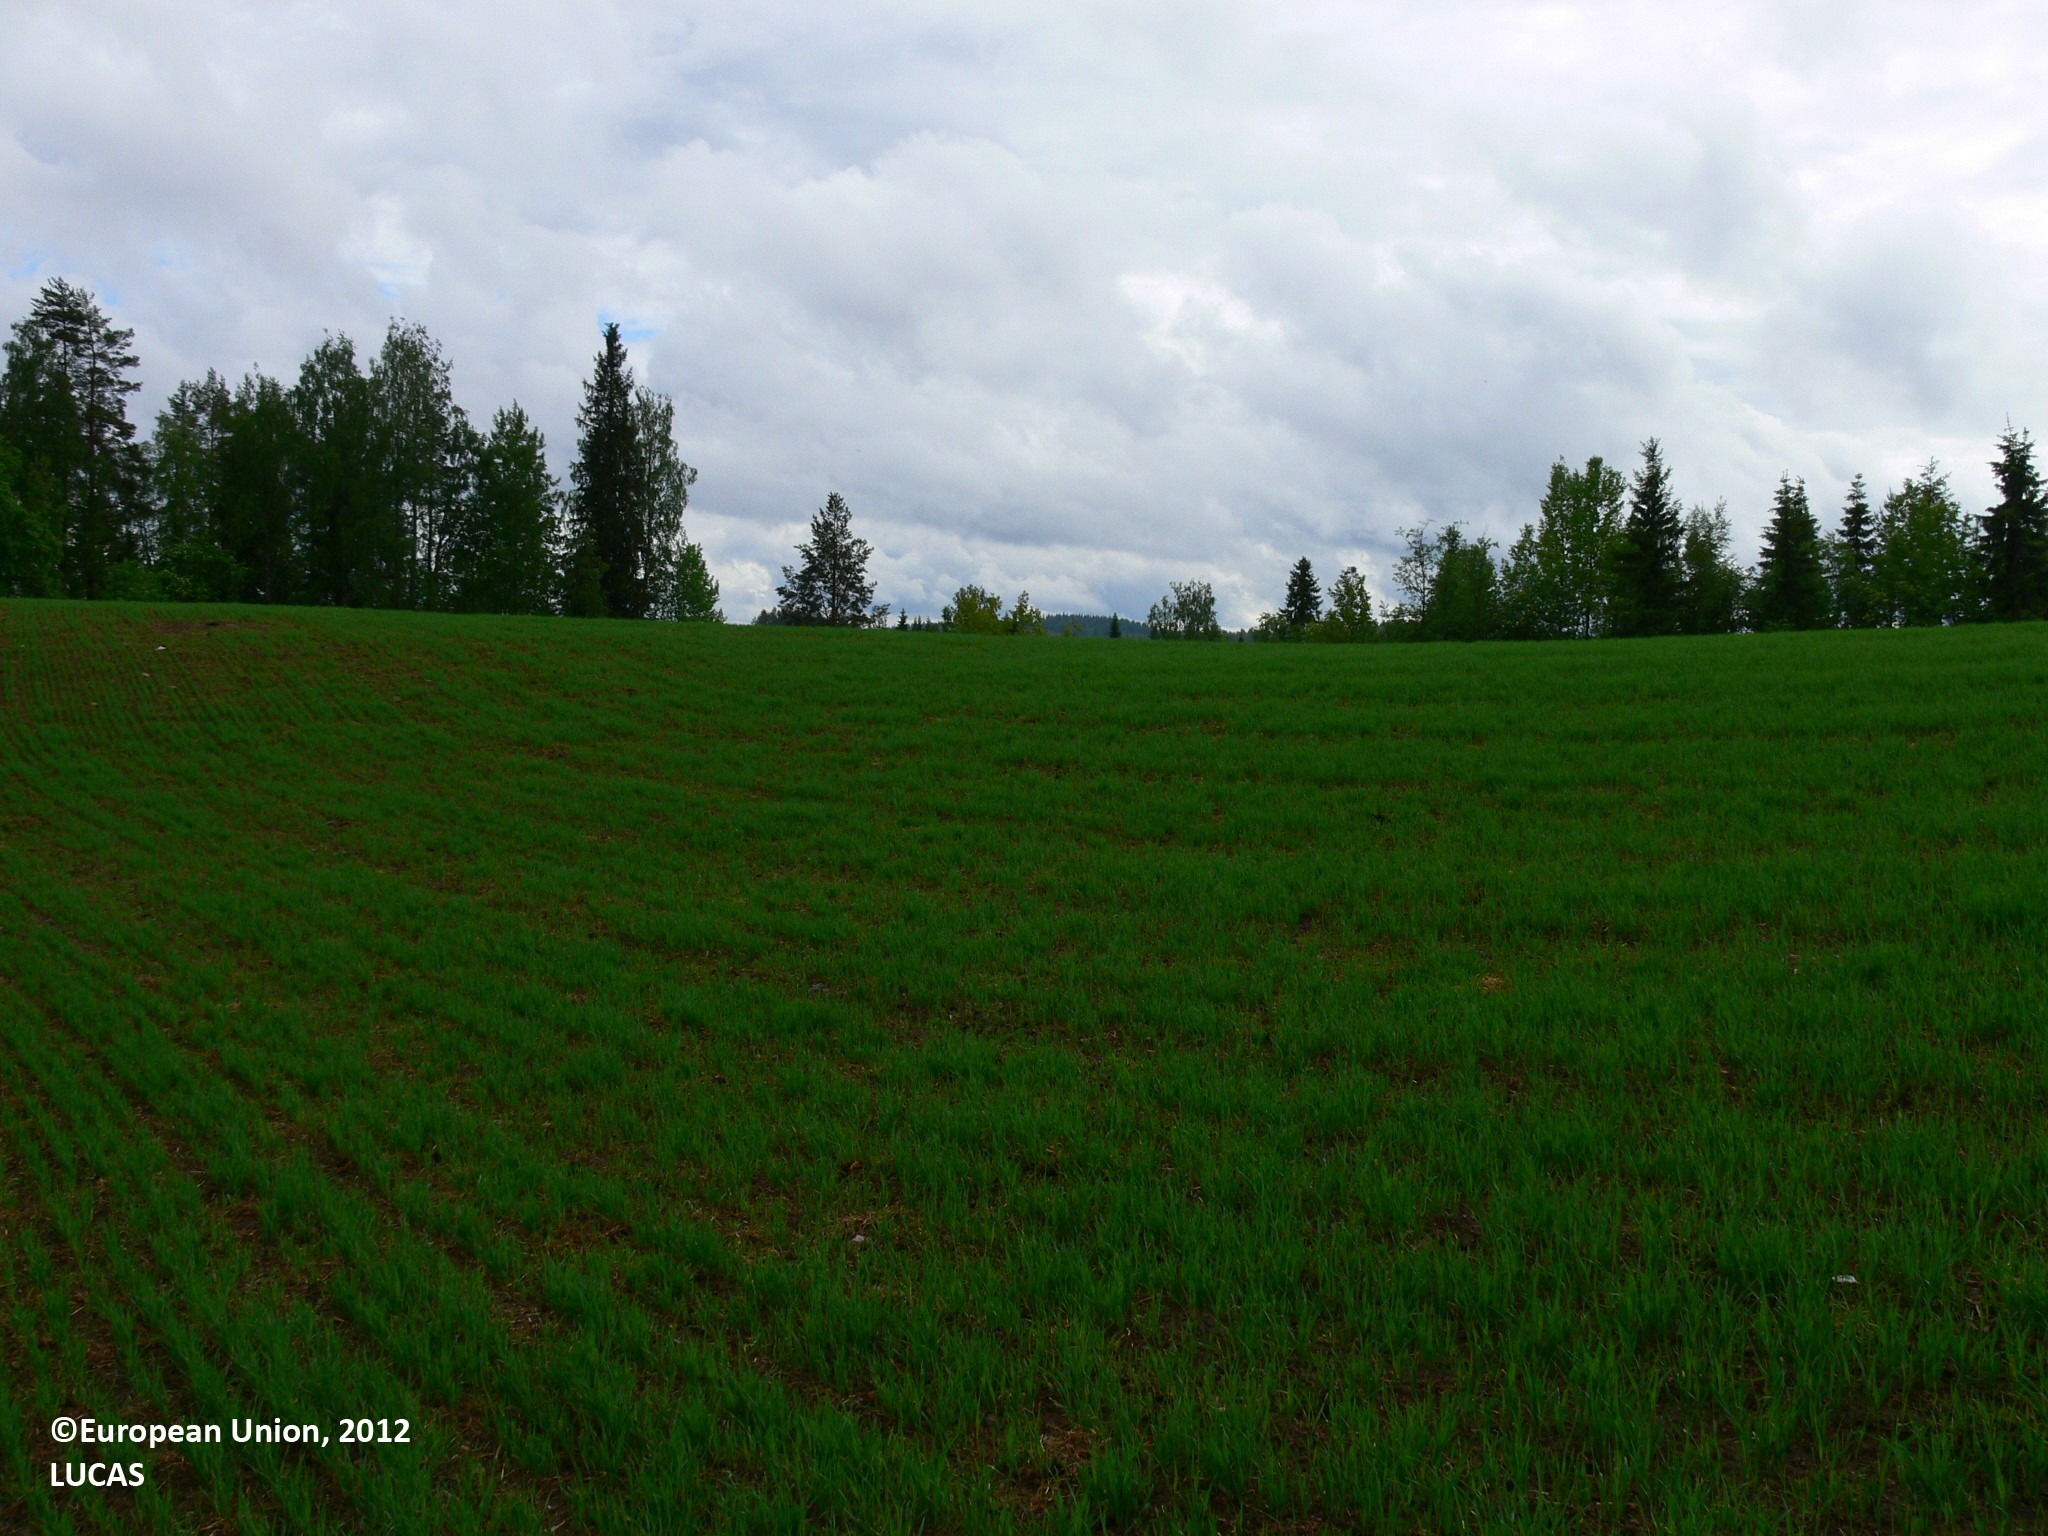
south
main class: Cropland
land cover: Oats
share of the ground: 25 - 50 %
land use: Agriculture (excluding fallow land and kitchen gardens)
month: June
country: FI
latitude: 62.4221
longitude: 30.4365
